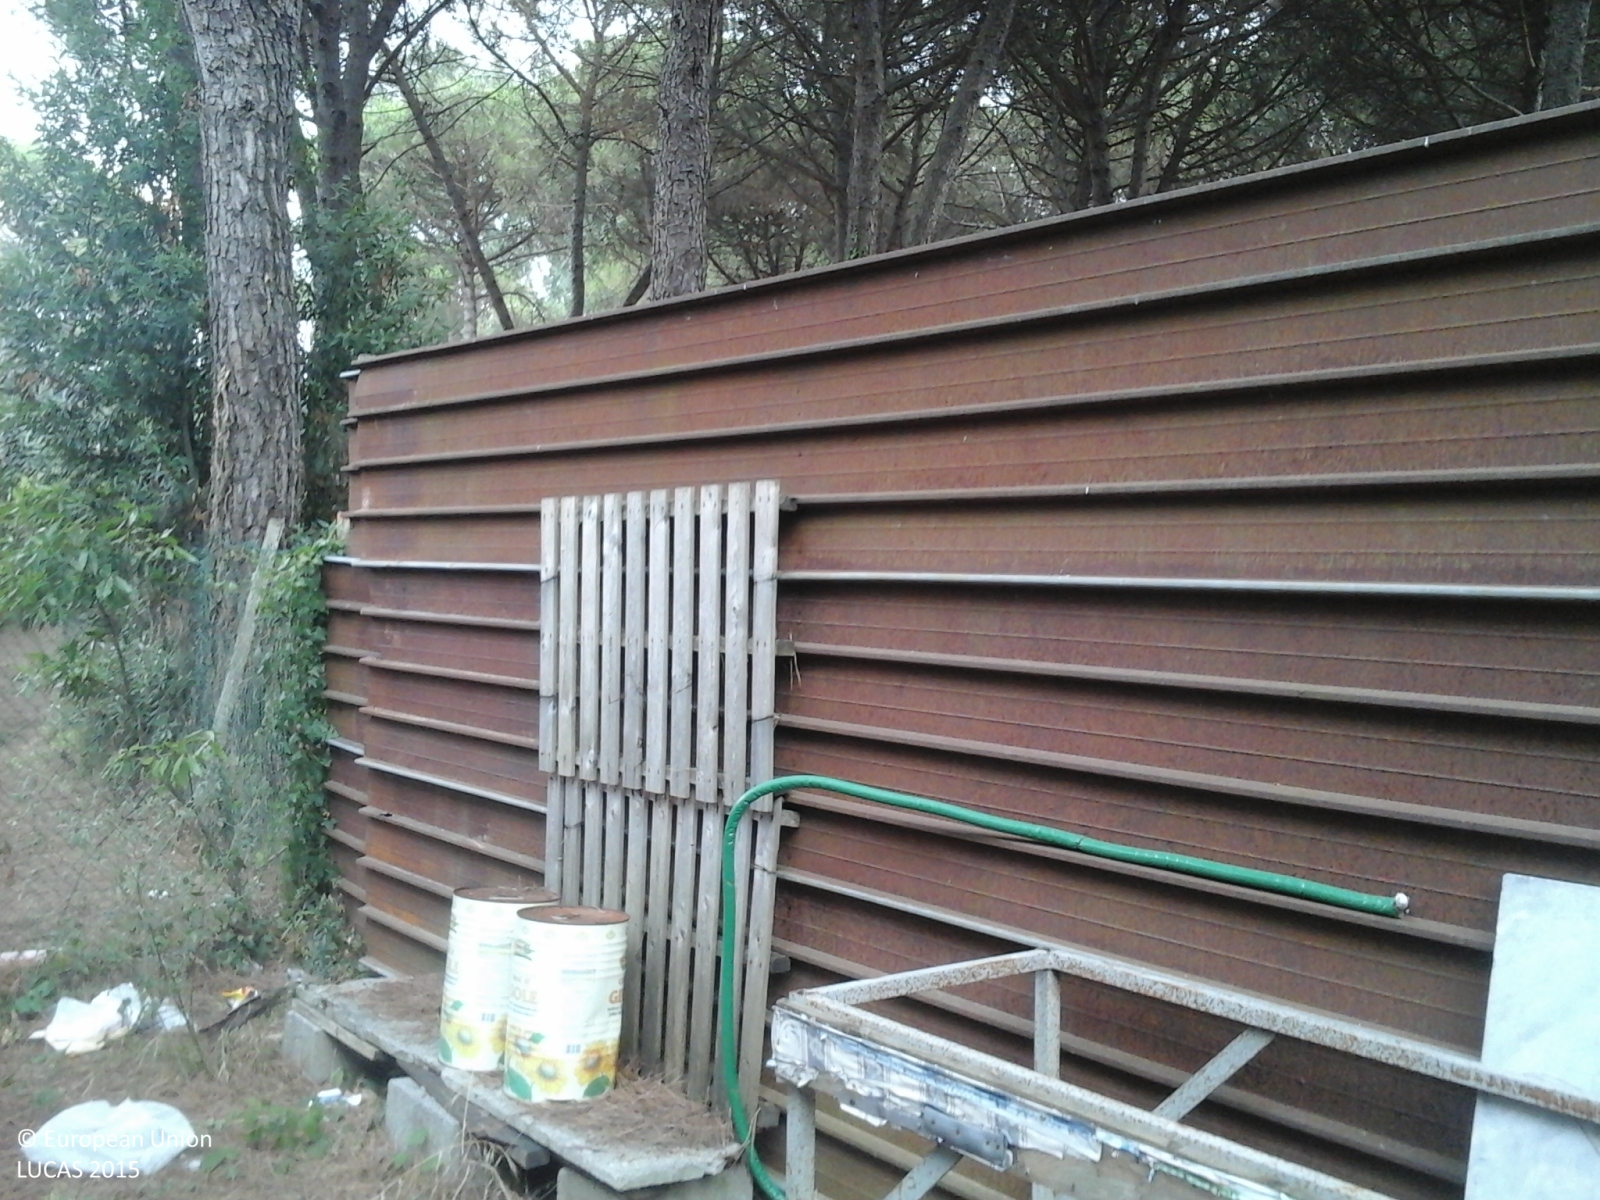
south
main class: Grassland
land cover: Grassland with sparse tree/shrub cover
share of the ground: > 75 %
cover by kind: herbaceous plants 95 %, coniferous forest trees 5 %
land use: Residential
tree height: > 5 m
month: August
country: IT
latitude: 43.8791
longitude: 10.7076
